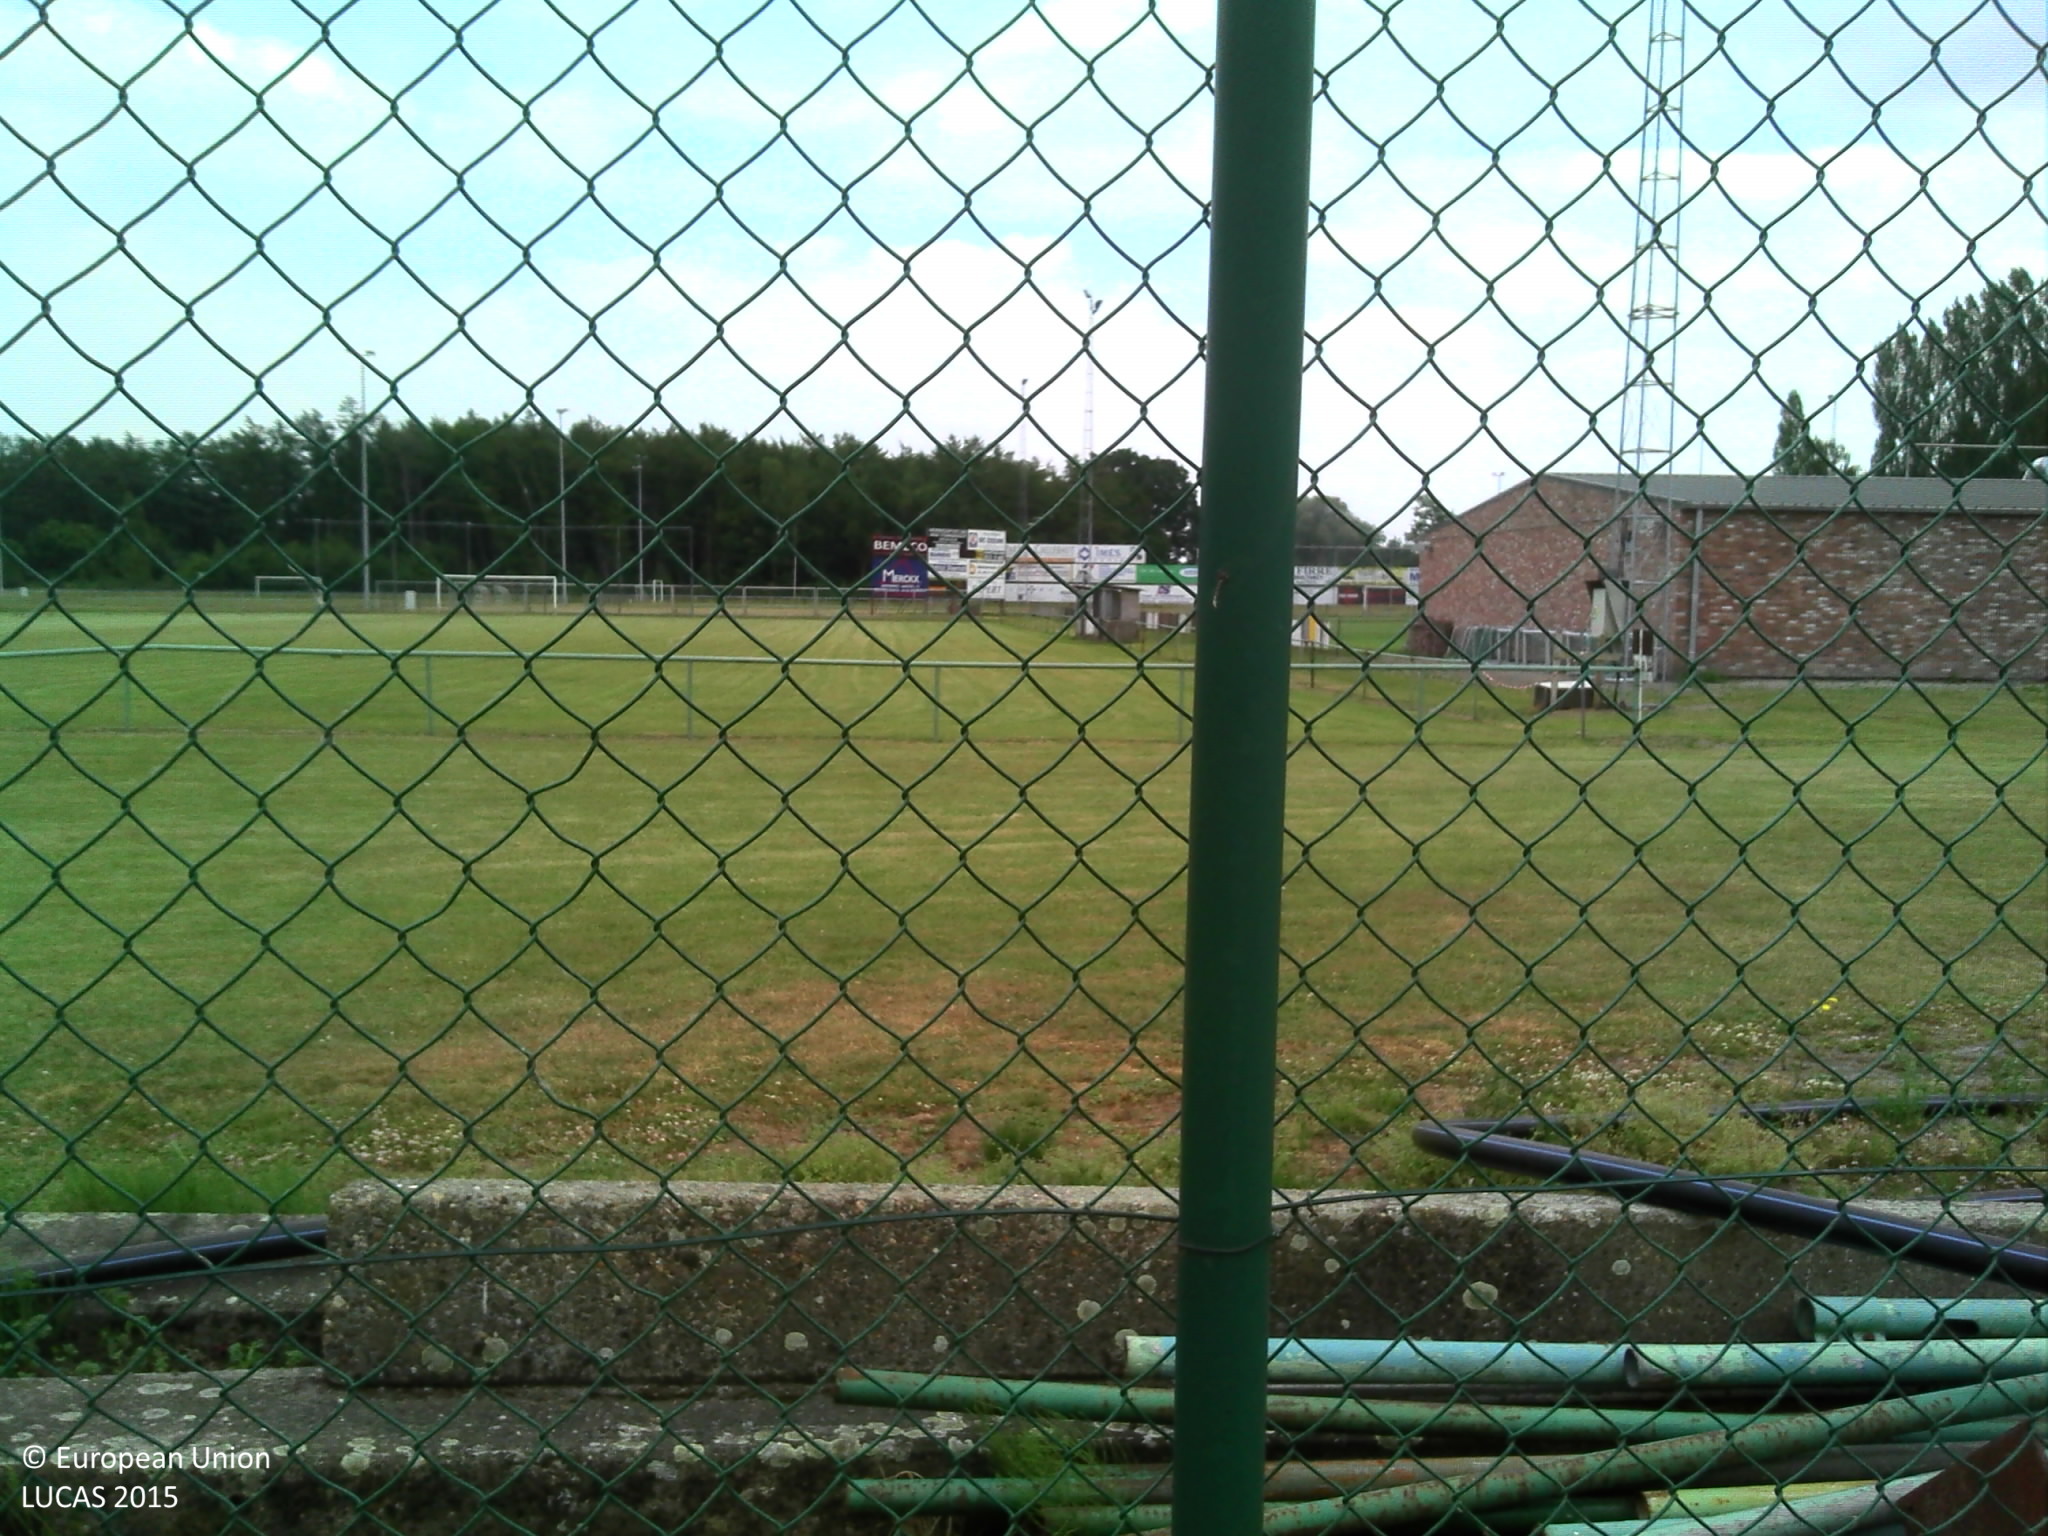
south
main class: Grassland
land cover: Grassland without tree/shrub cover
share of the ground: > 75 %
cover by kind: herbaceous plants 100 %
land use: Sport
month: June
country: BE
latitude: 51.2175
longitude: 4.0241
